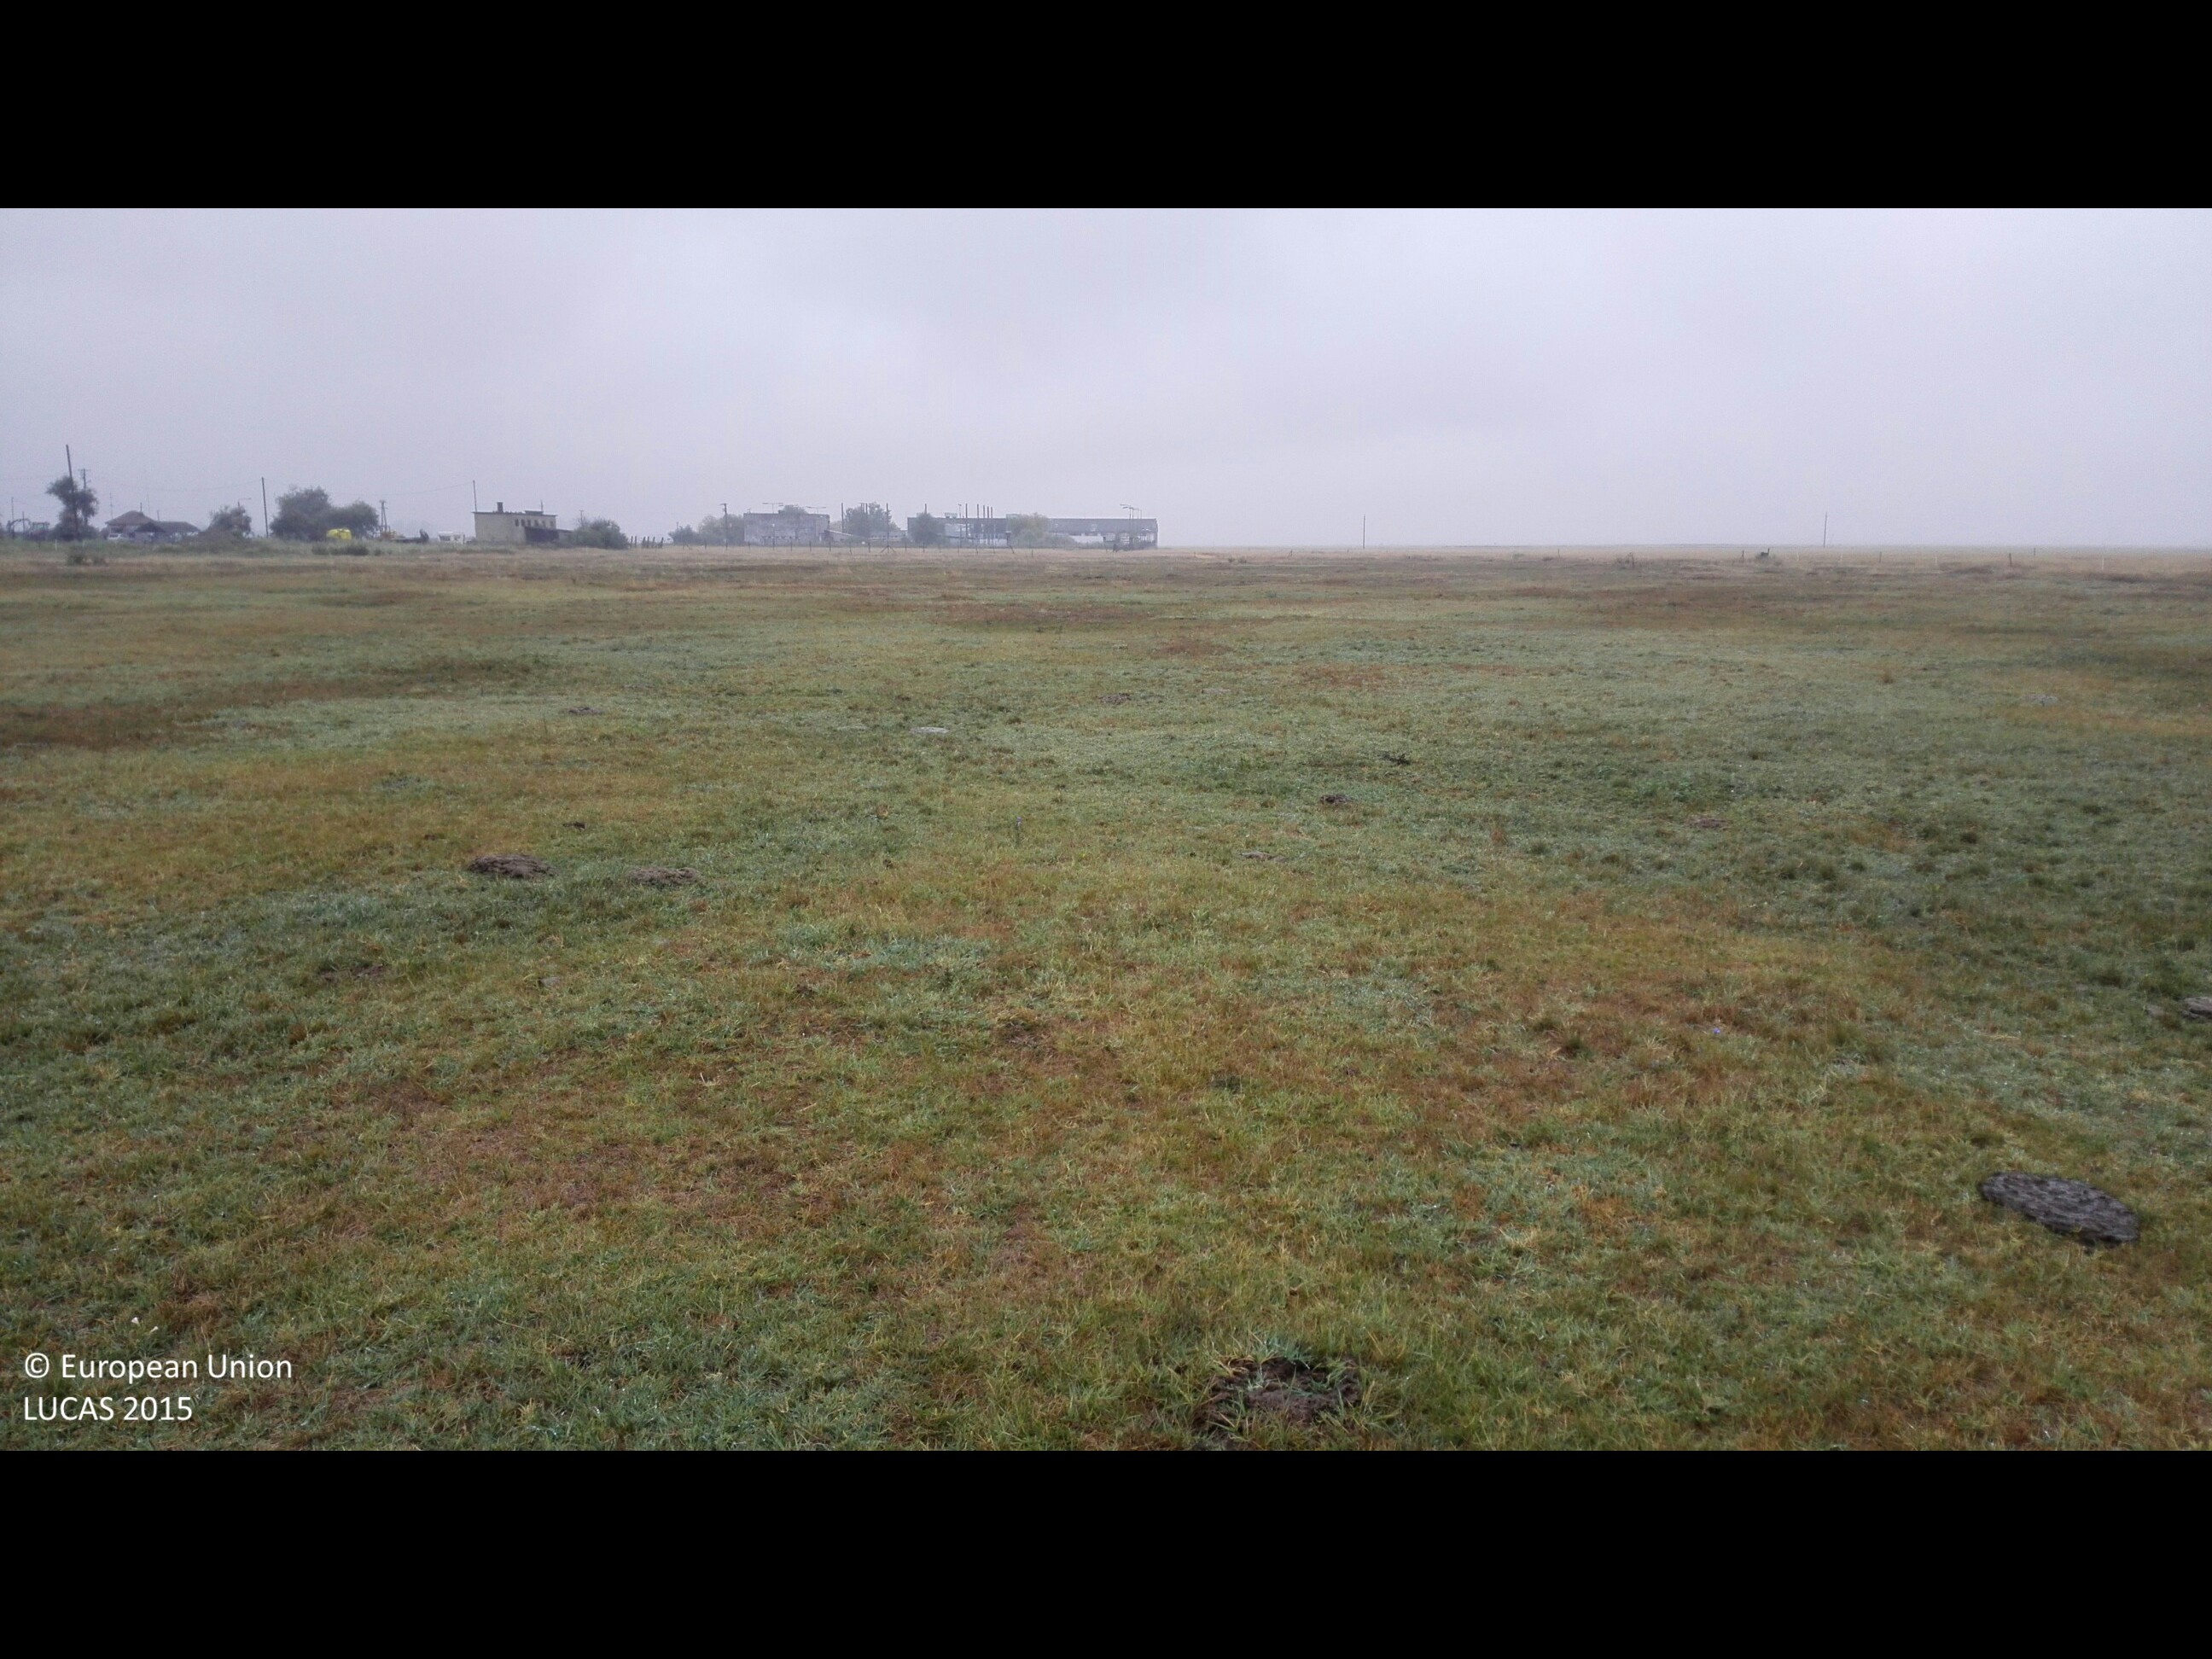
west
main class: Grassland
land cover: Grassland without tree/shrub cover
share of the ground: > 75 %
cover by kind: herbaceous plants 100 %
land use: Agriculture (excluding fallow land and kitchen gardens)
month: August
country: HU
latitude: 47.1861
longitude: 21.6432
